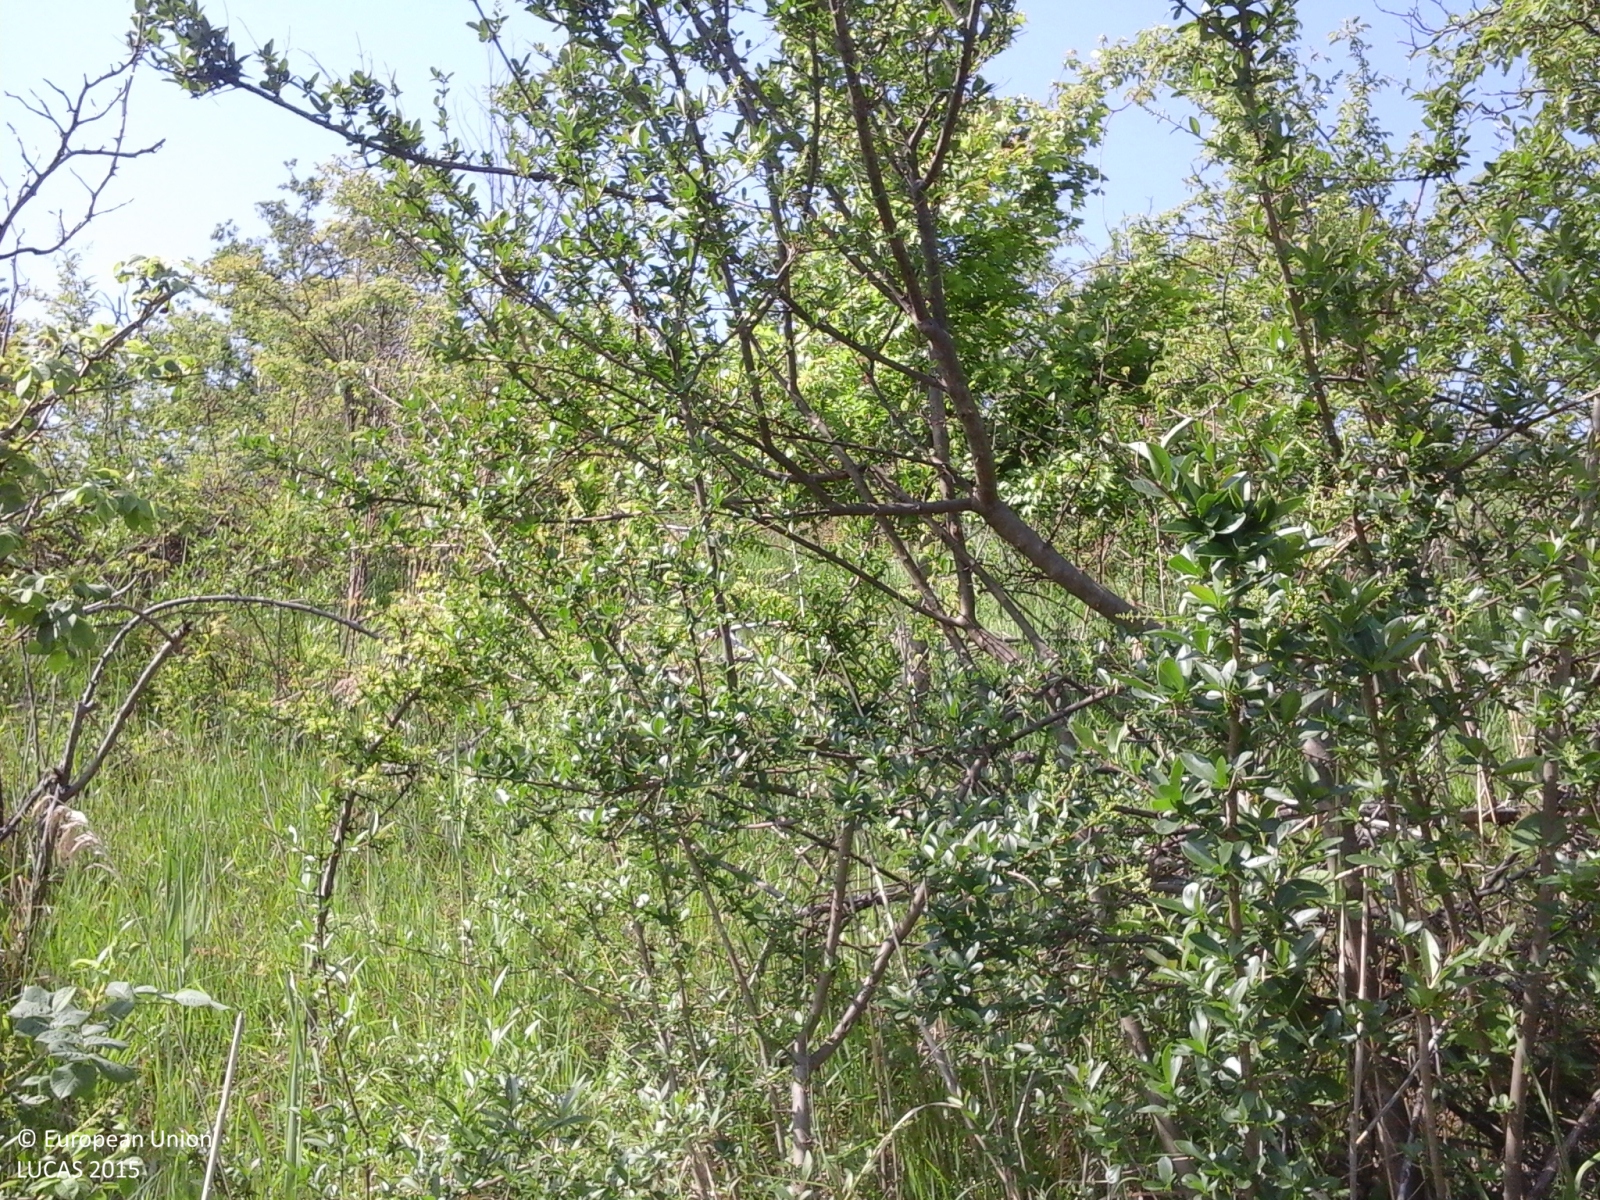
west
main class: Shrubland
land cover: Shrubland with sparse tree cover
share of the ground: 50 - 75 %
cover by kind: shrubs 60 %, herbaceous plants 35 %, broadleaved forest trees 5 %
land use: Semi-natural and natural areas not in use
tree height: > 5 m
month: May
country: IT
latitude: 44.4734
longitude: 10.8404
